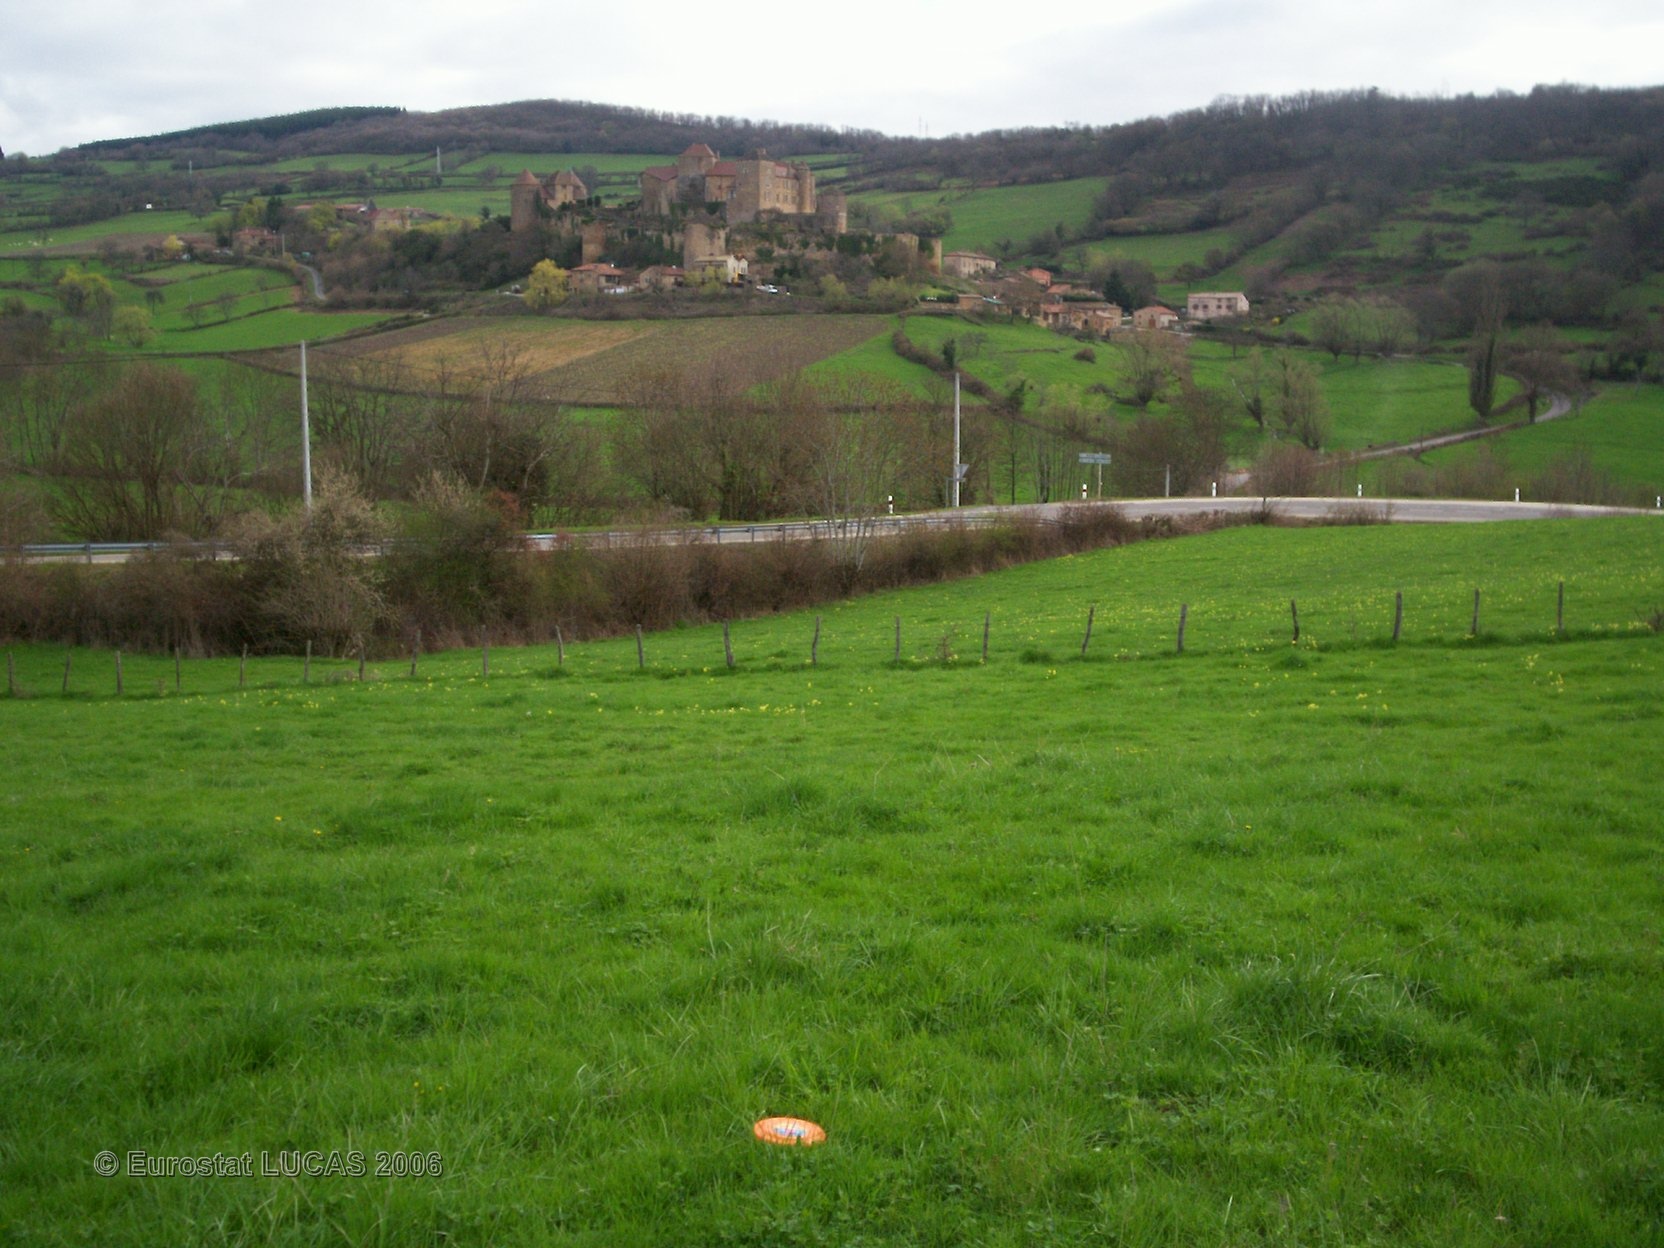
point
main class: Grassland
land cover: Grassland without tree/shrub cover
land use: Agriculture (excluding fallow land and kitchen gardens)
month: April
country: FR
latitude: 46.3815
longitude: 4.6841
